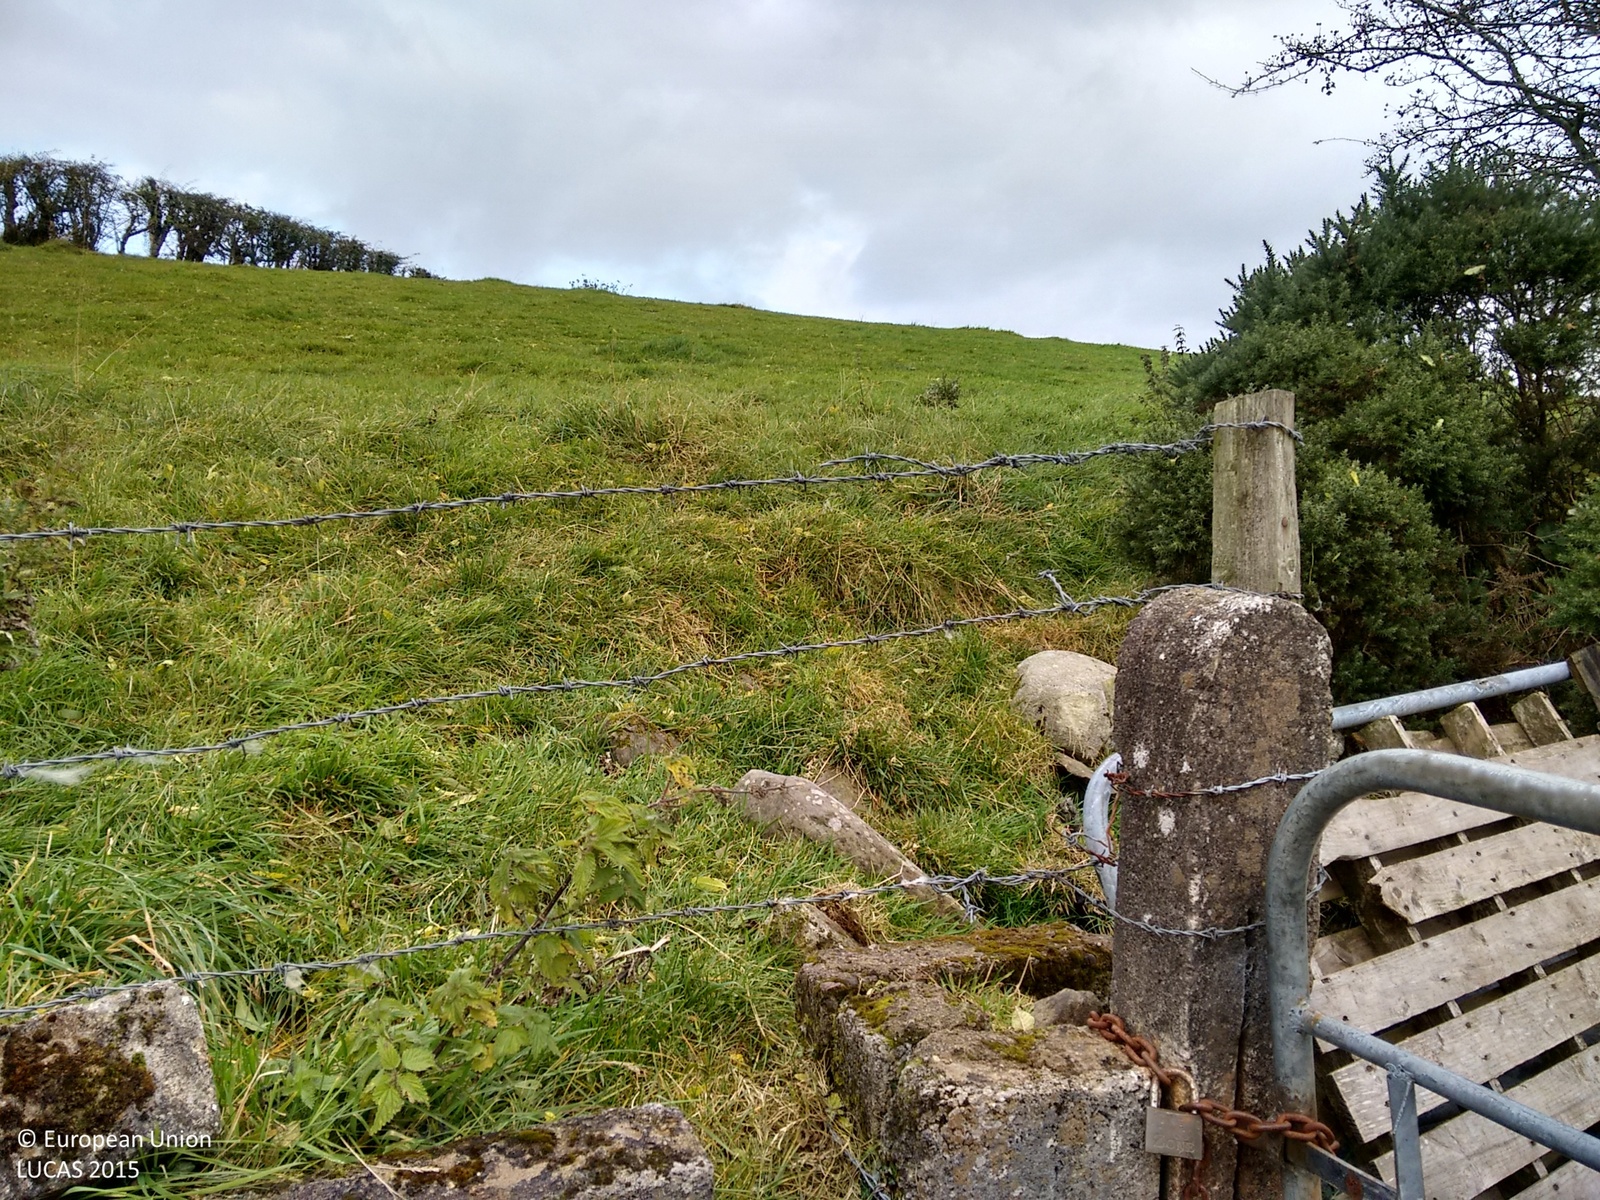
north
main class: Grassland
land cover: Grassland without tree/shrub cover
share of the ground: > 75 %
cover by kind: herbaceous plants 100 %
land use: Agriculture (excluding fallow land and kitchen gardens)
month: October
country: GB
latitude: 54.4570
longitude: -7.4777
